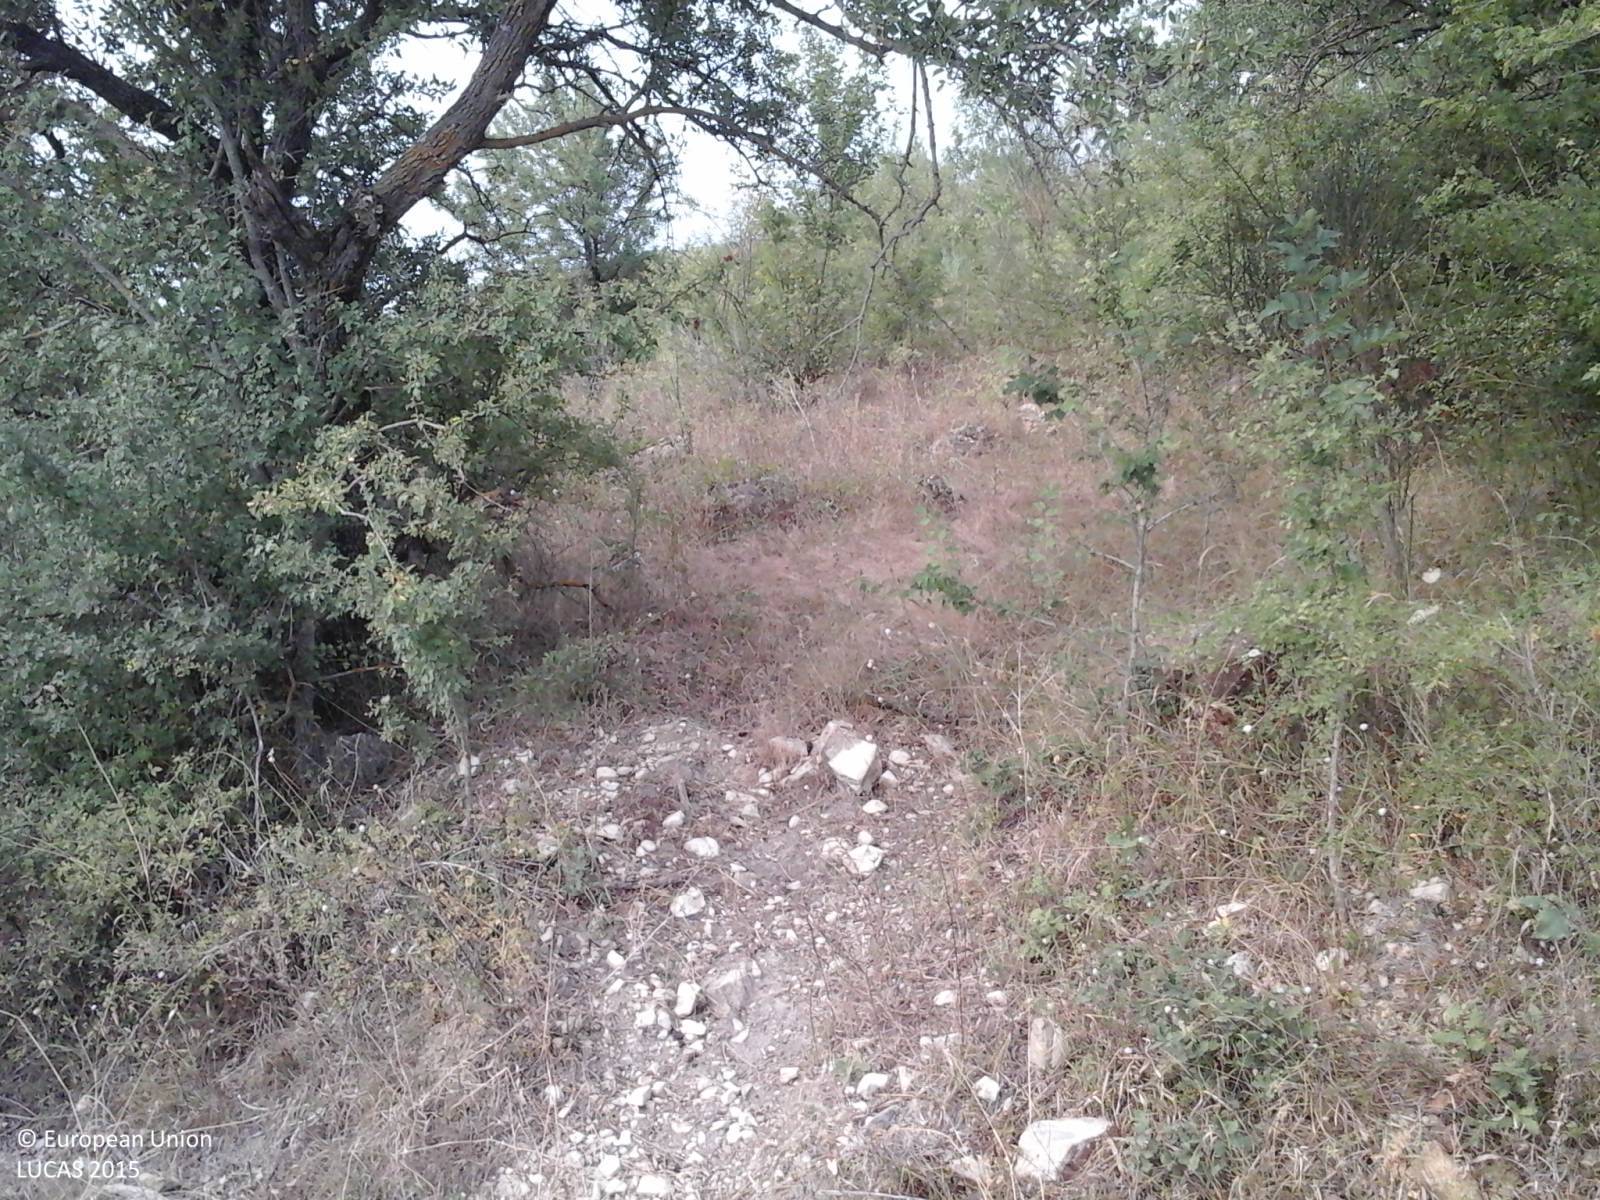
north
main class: Woodland
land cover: Broadleaved woodland
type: thermophilous deciduous forest
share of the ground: > 75 %
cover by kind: broadleaved forest trees 100 %
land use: Forestry
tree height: > 5 m
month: August
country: IT
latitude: 42.1998
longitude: 12.0394
